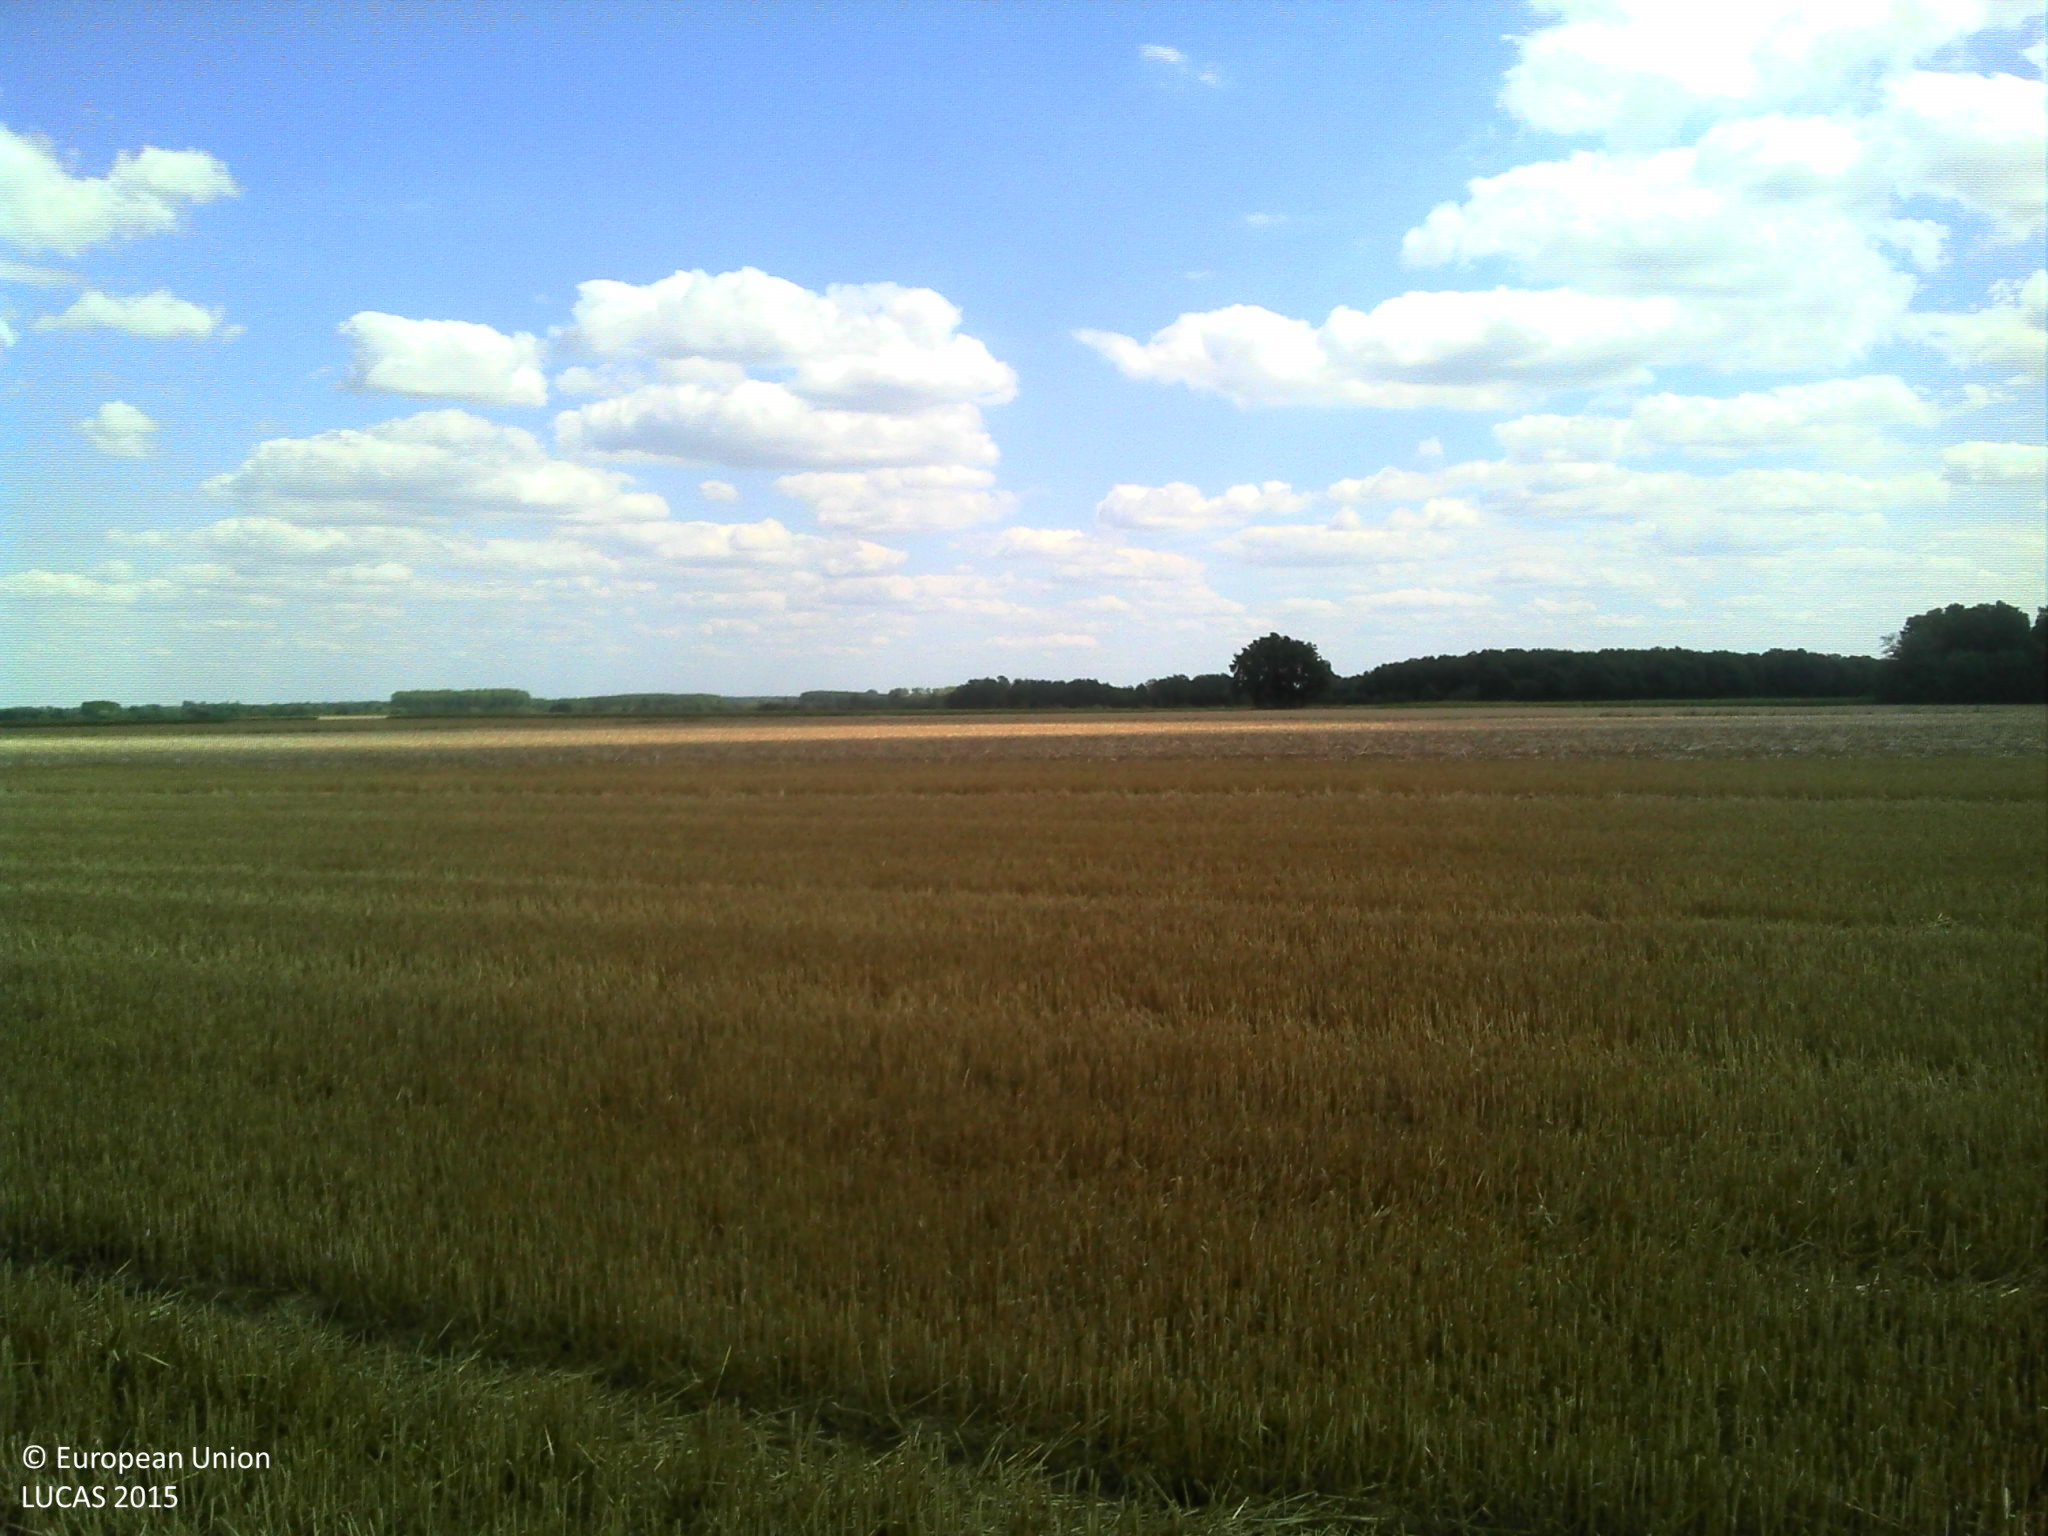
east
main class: Cropland
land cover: Common wheat
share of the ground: > 75 %
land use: Agriculture (excluding fallow land and kitchen gardens)
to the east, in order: Common wheat; Other bare soil
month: July
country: FR
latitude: 46.6814
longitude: 4.9159
